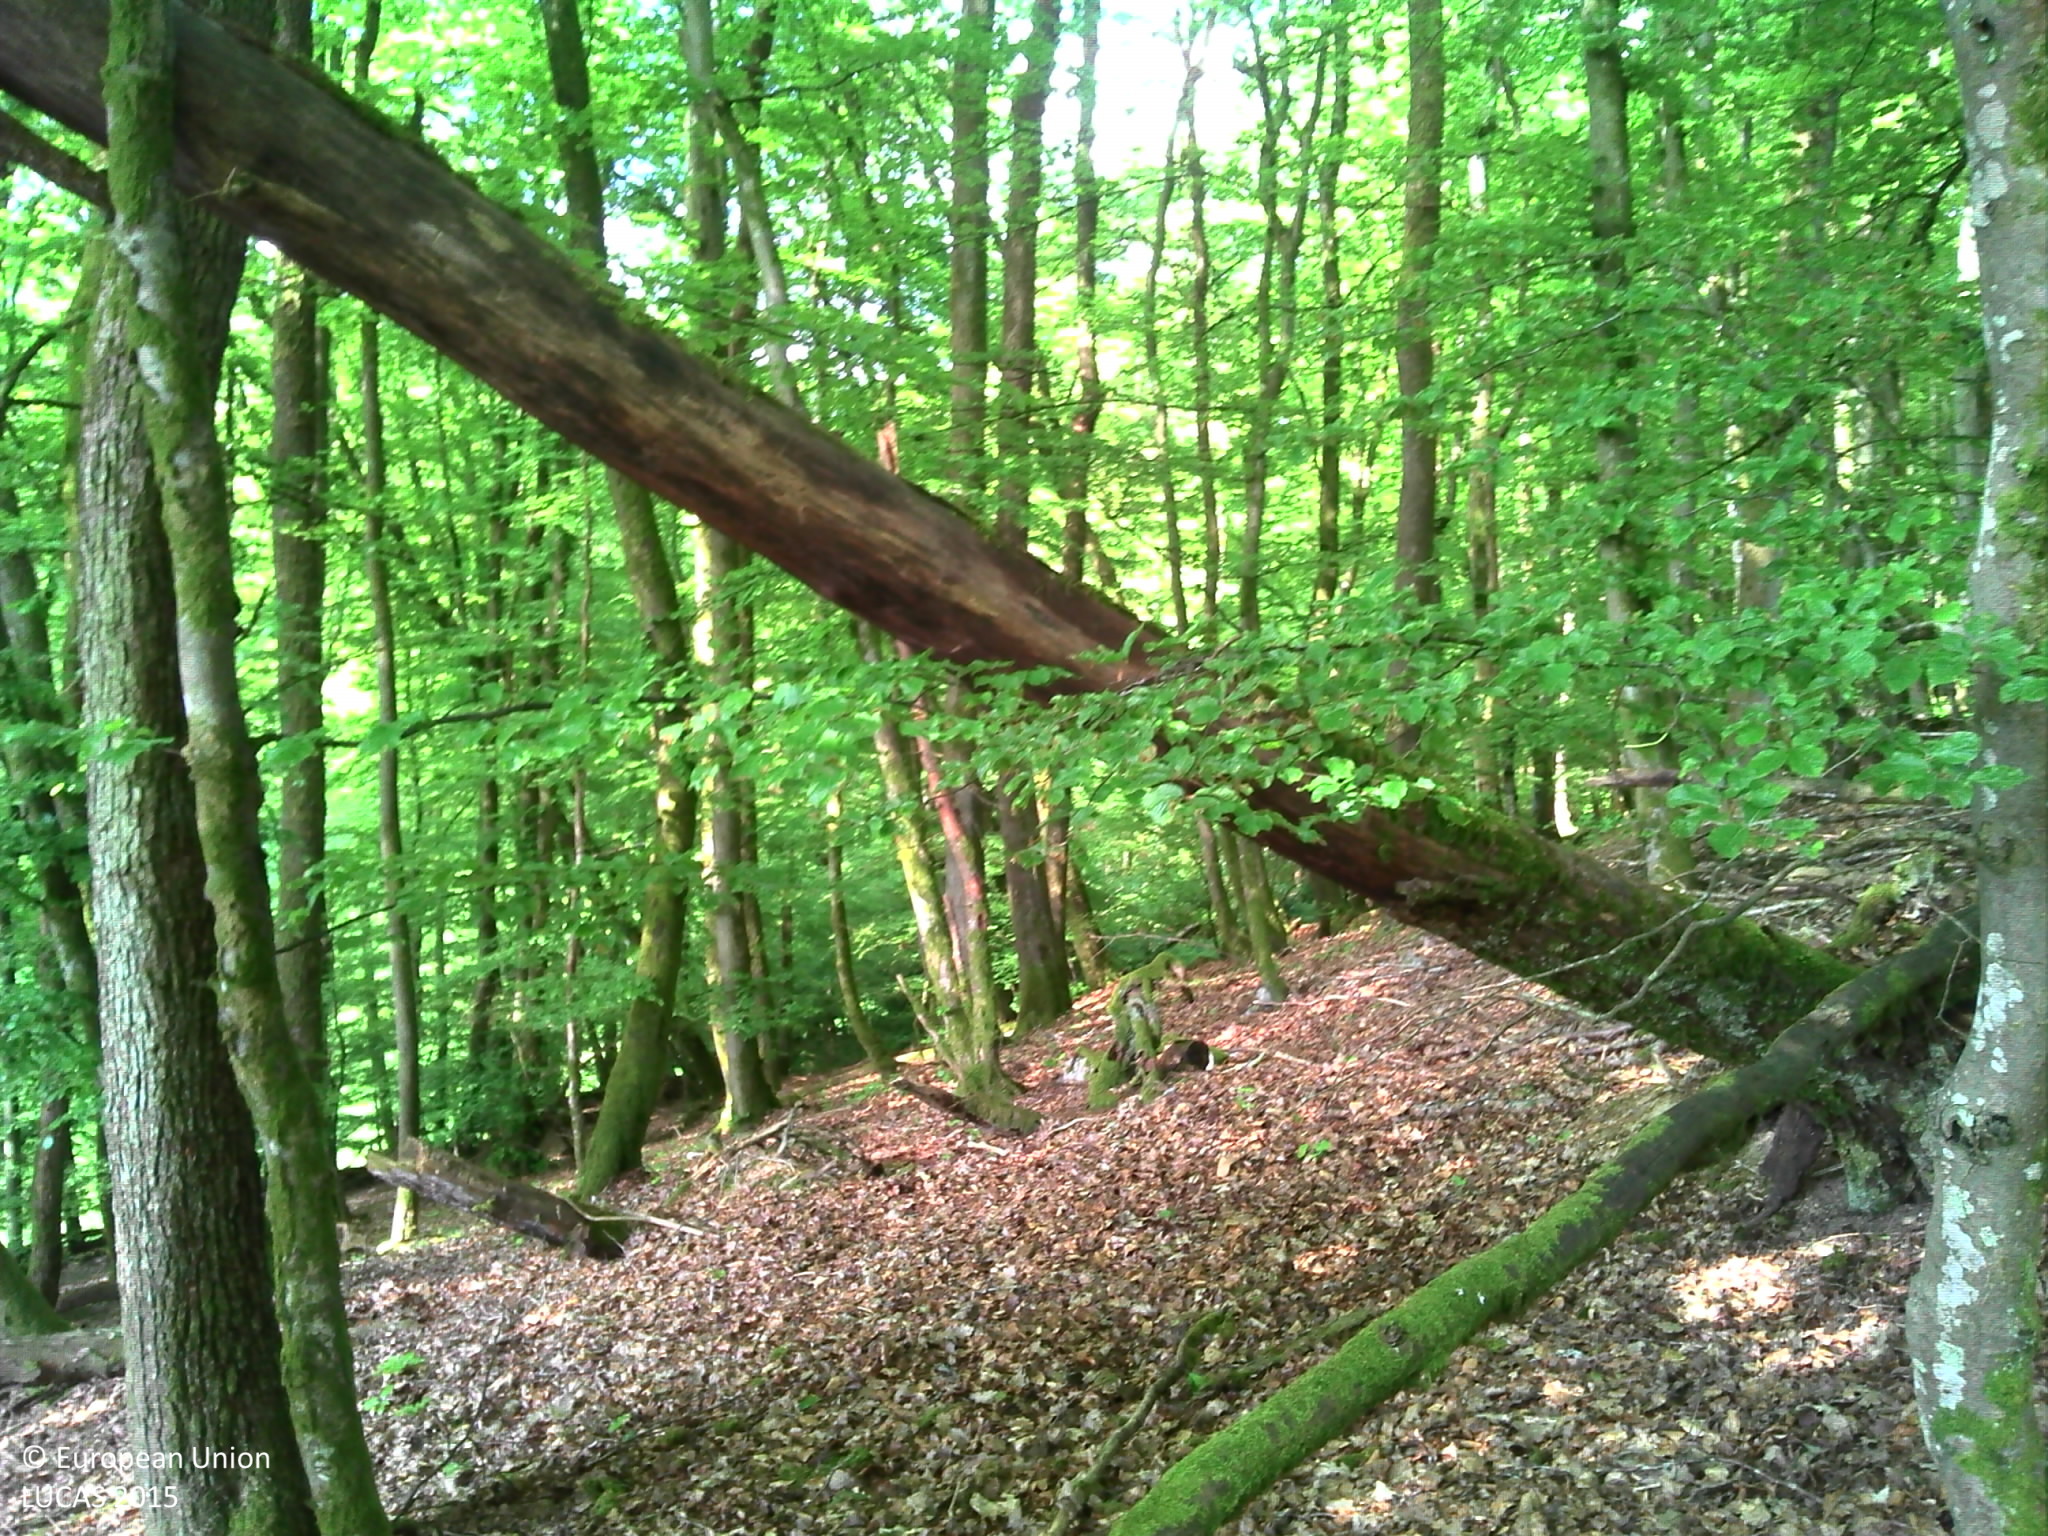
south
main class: Woodland
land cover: Broadleaved woodland
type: acidophilous oak and oak-birch forest
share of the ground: > 75 %
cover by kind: broadleaved forest trees 95 %, lichens and mosses 5 %
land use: Forestry
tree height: > 5 m
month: May
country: LU
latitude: 49.8802
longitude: 6.0051
